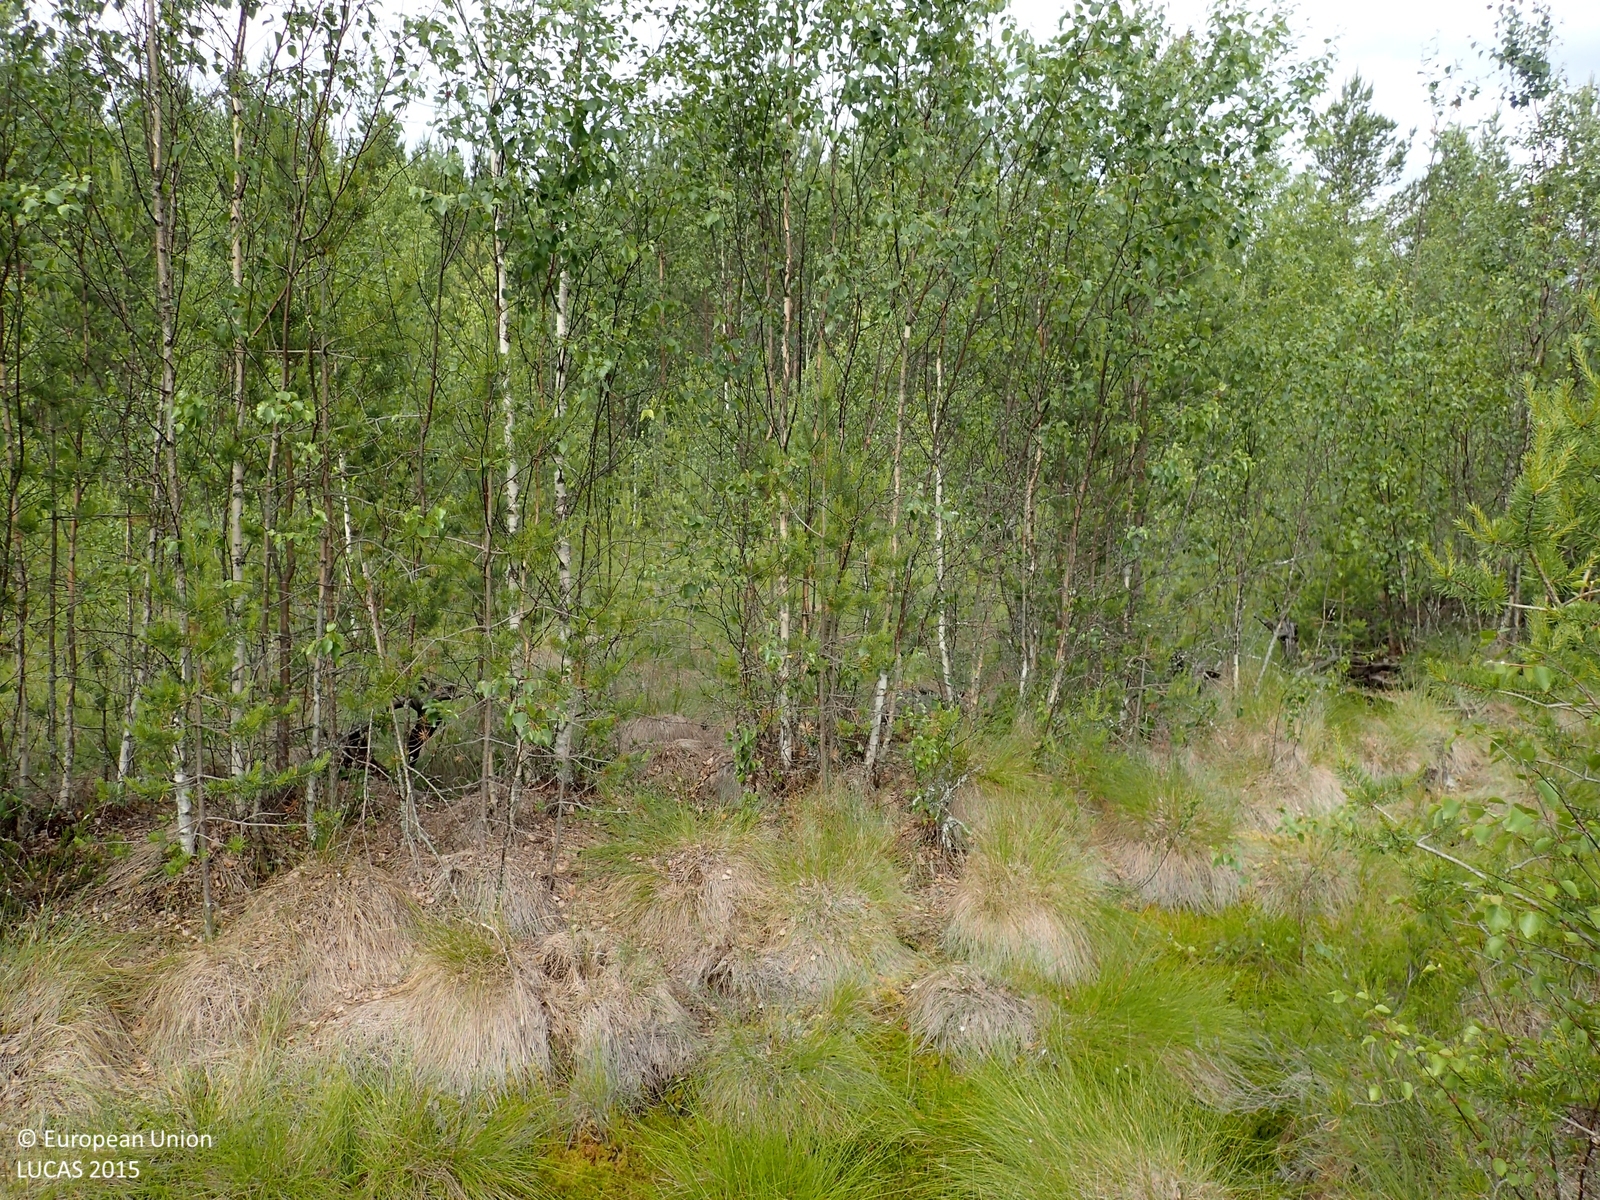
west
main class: Woodland
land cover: Pine dominated mixed woodland
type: mire and swamp forests
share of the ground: 25 - 50 %
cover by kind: herbaceous plants 50 %, unconsolidated bare surface 20 %, coniferous forest trees 15 %, broadleaved forest trees 15 %
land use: Forestry
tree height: < 5 m
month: July
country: FI
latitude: 62.6394
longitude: 21.3331
